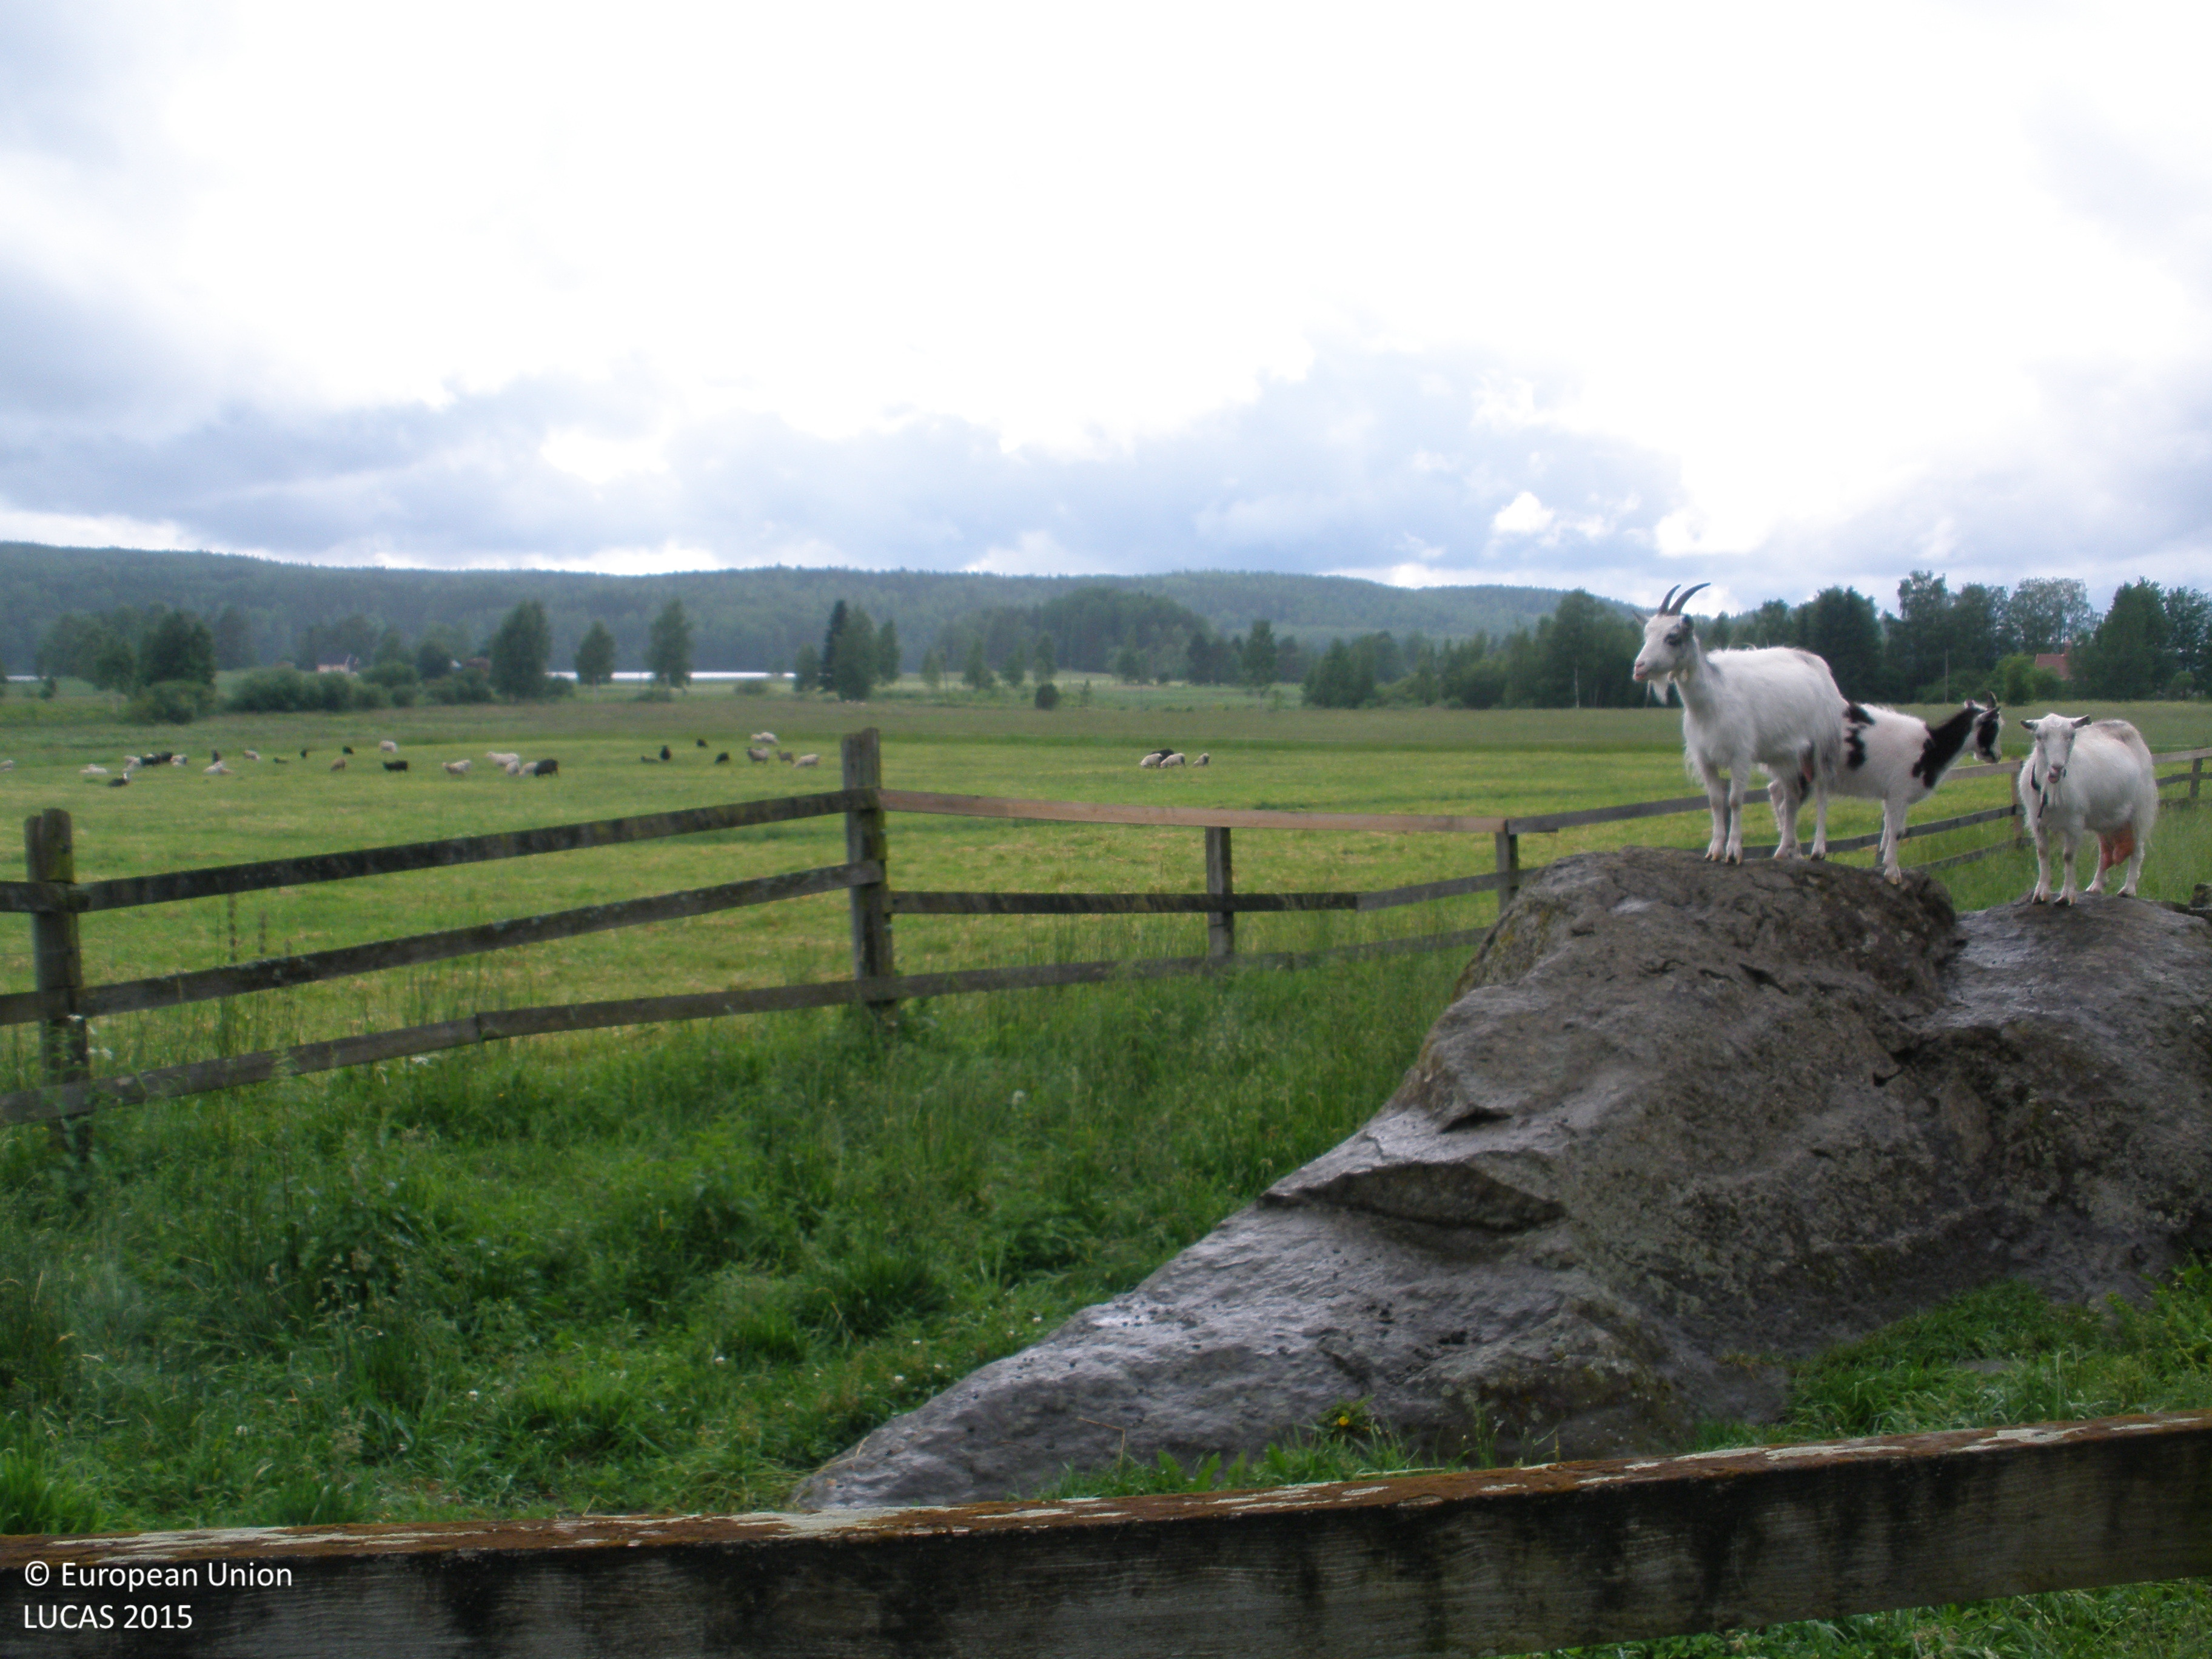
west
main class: Cropland
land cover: Temporary grasslands
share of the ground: 25 - 50 %
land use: Agriculture (excluding fallow land and kitchen gardens)
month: July
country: FI
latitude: 61.4190
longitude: 23.2485
